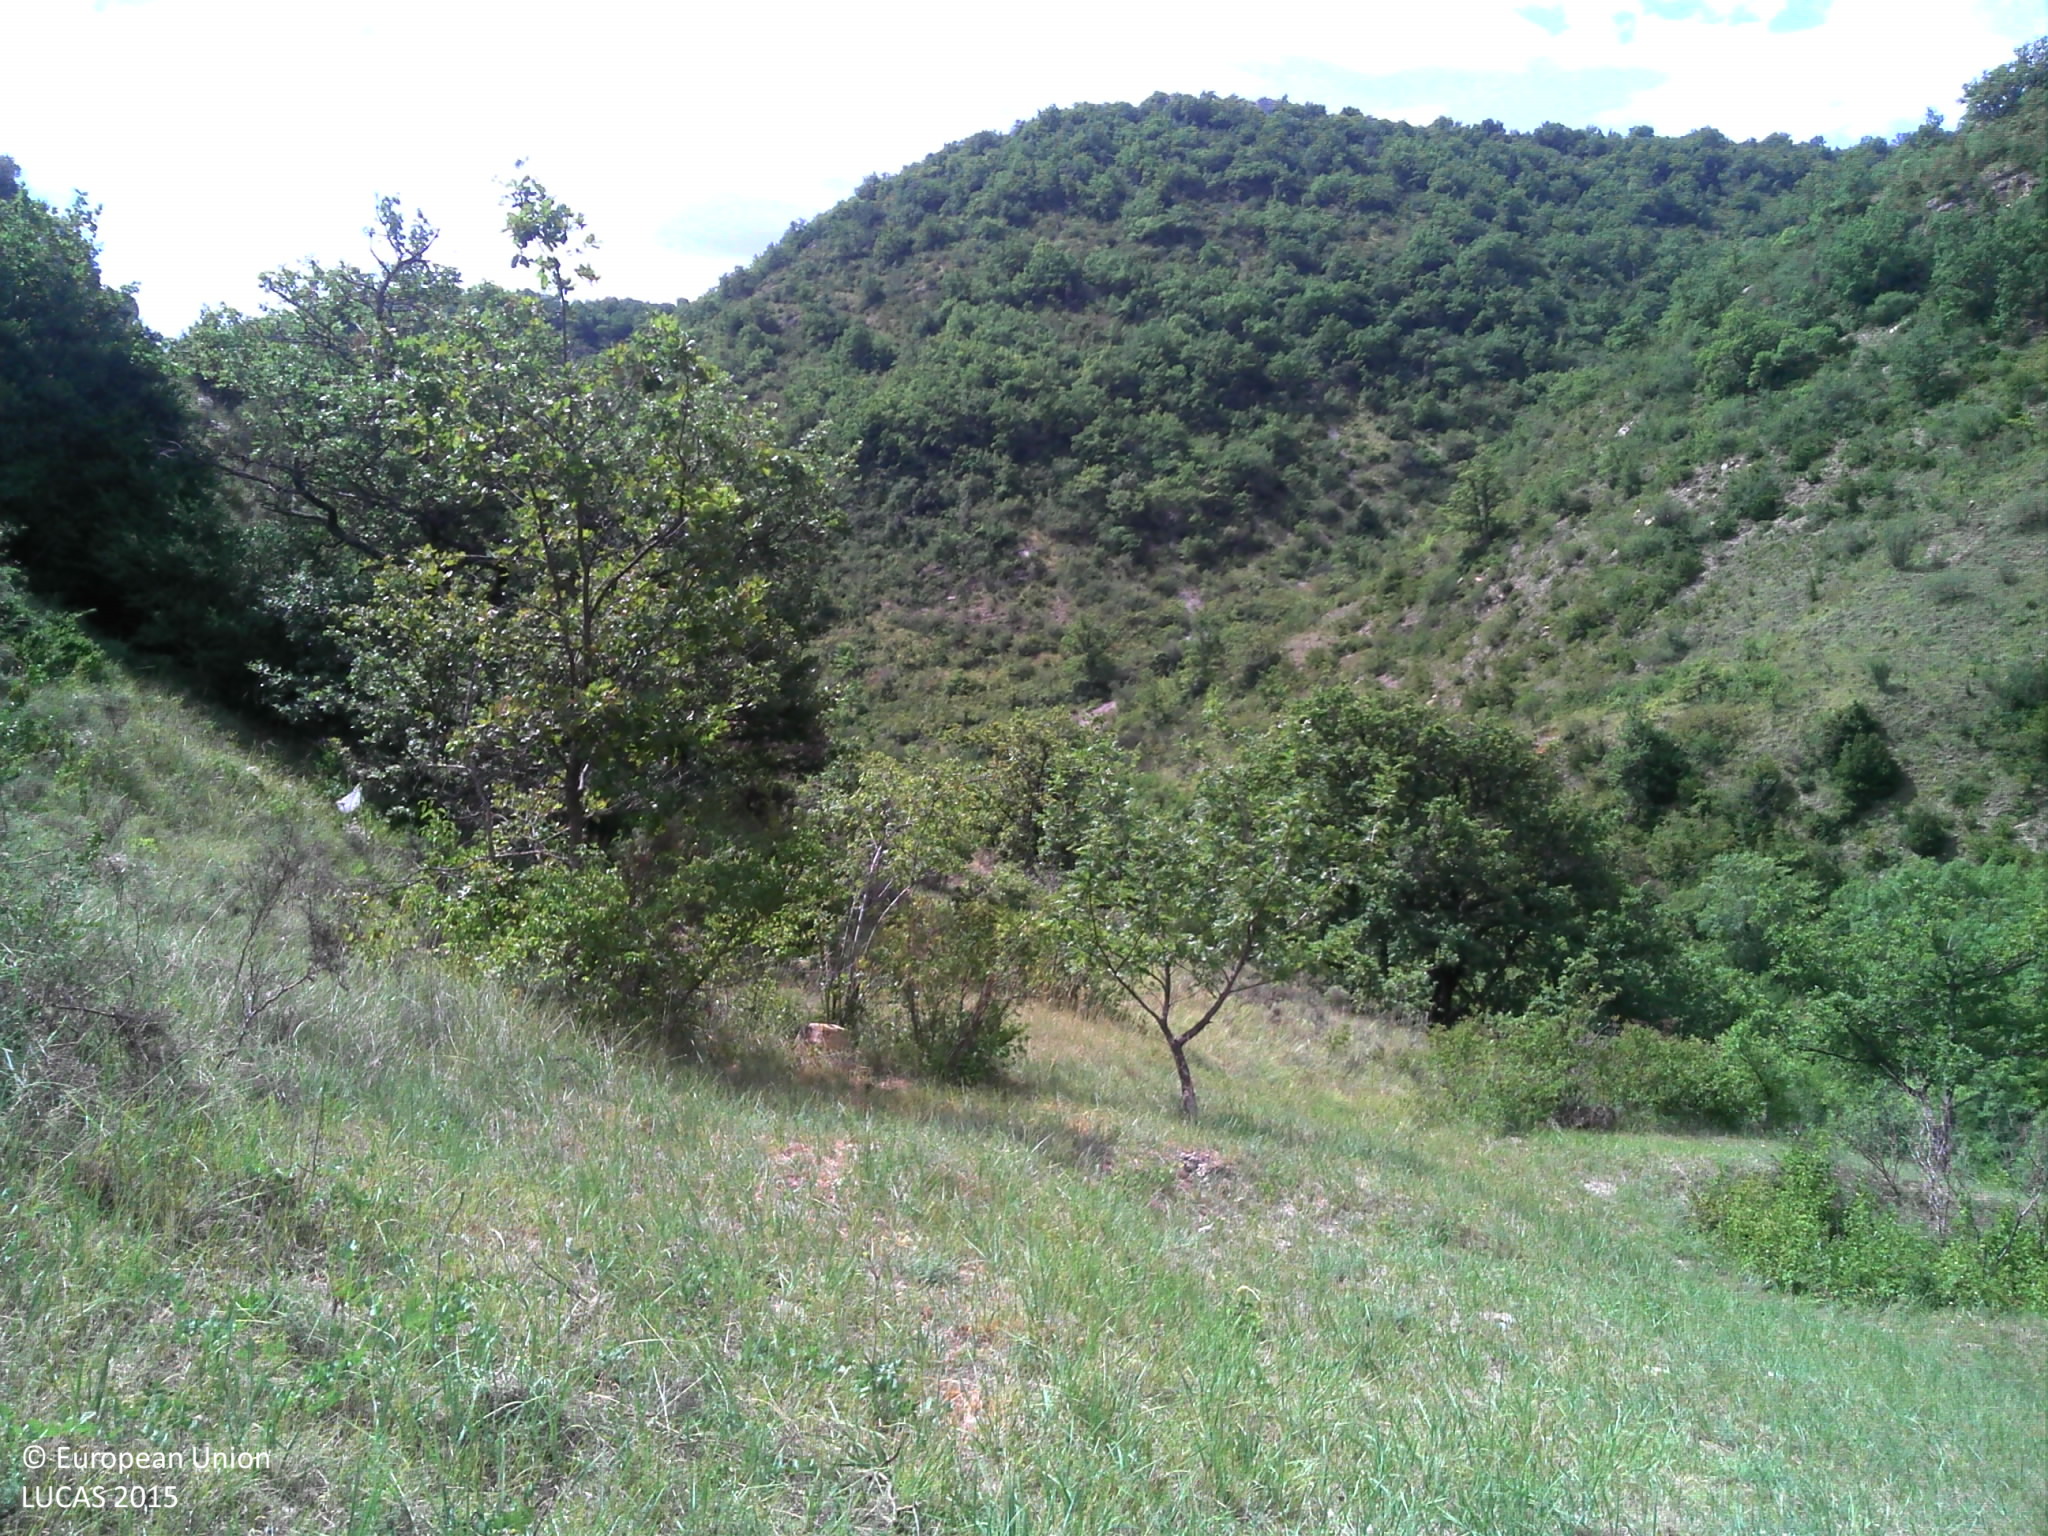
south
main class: Woodland
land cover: Broadleaved woodland
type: broadleaved evergreen forest
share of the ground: > 75 %
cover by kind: broadleaved forest trees 100 %
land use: Semi-natural and natural areas not in use
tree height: > 5 m
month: July
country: FR
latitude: 44.7373
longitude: 4.6643
